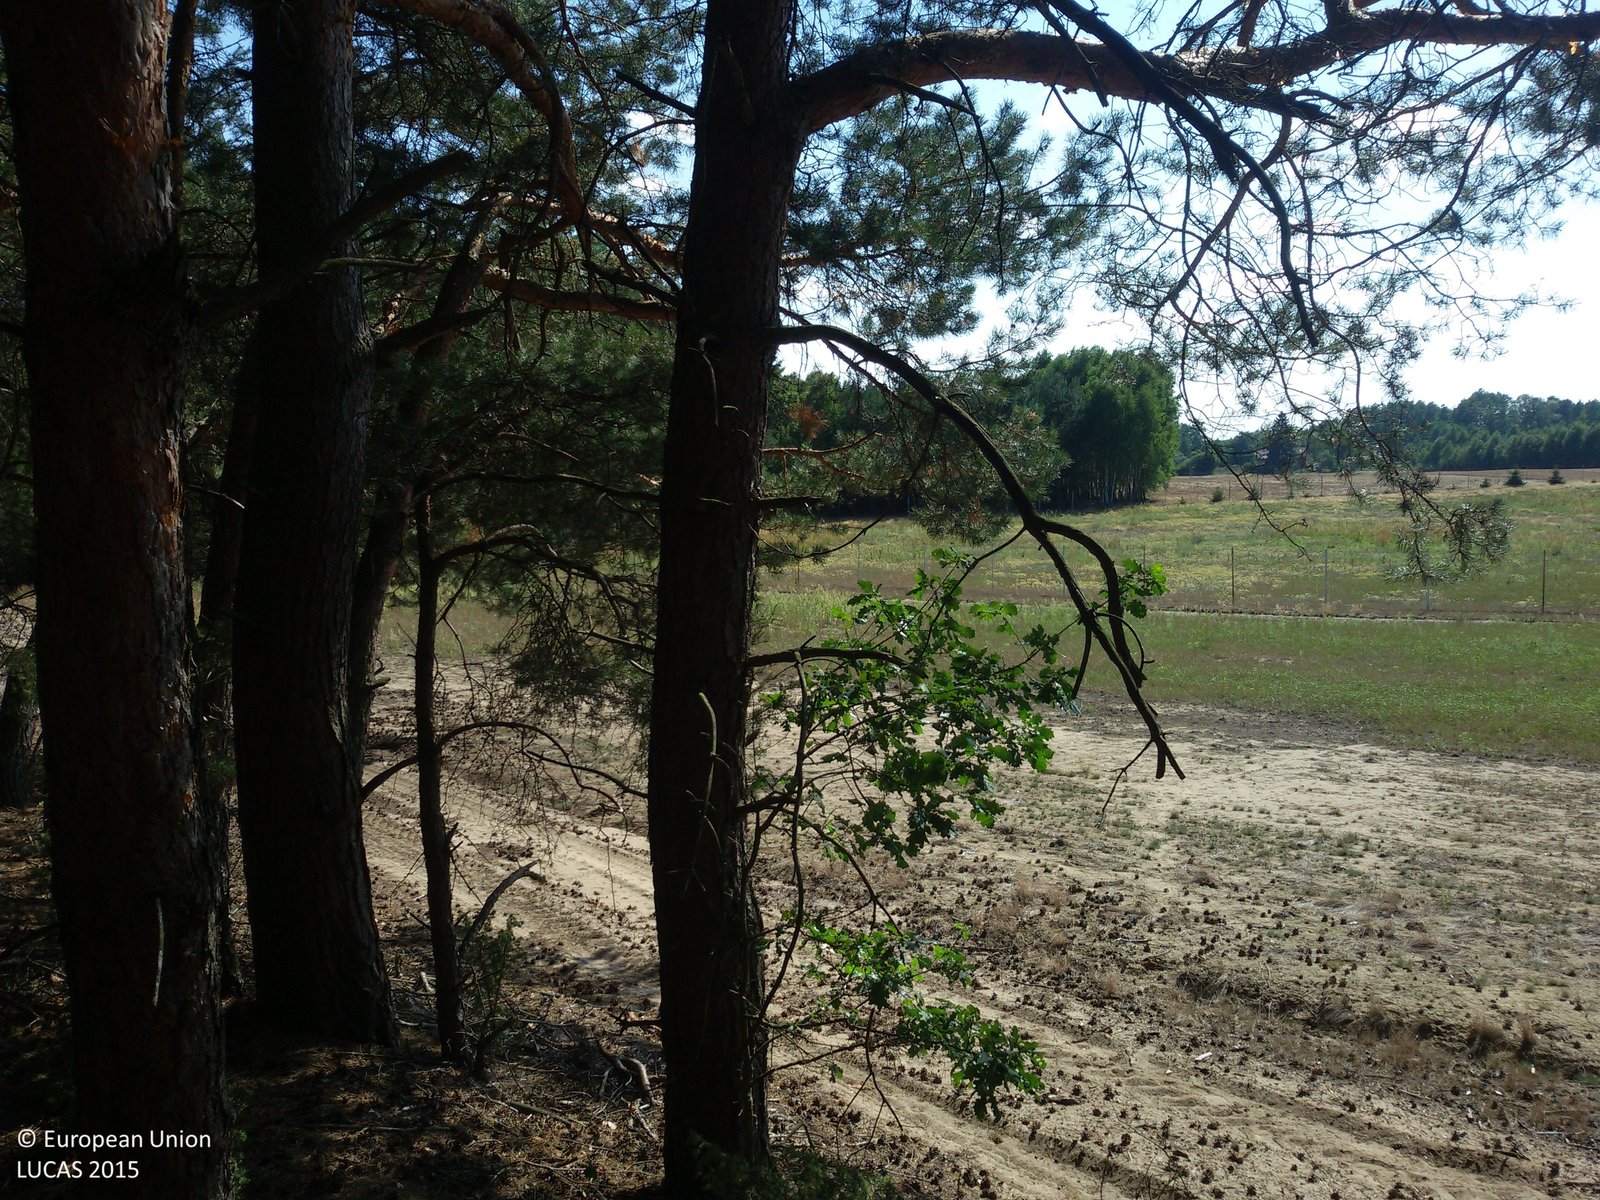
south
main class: Woodland
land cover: Pine dominated coniferous woodland
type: hemiboreal forest and nemoral coniferous forest and mixed broadleaved-coniferous forest
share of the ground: > 75 %
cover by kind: coniferous forest trees 80 %, lichens and mosses 15 %, herbaceous plants 5 %
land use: Forestry
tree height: > 5 m
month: August
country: PL
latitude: 52.8173
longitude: 20.0785
